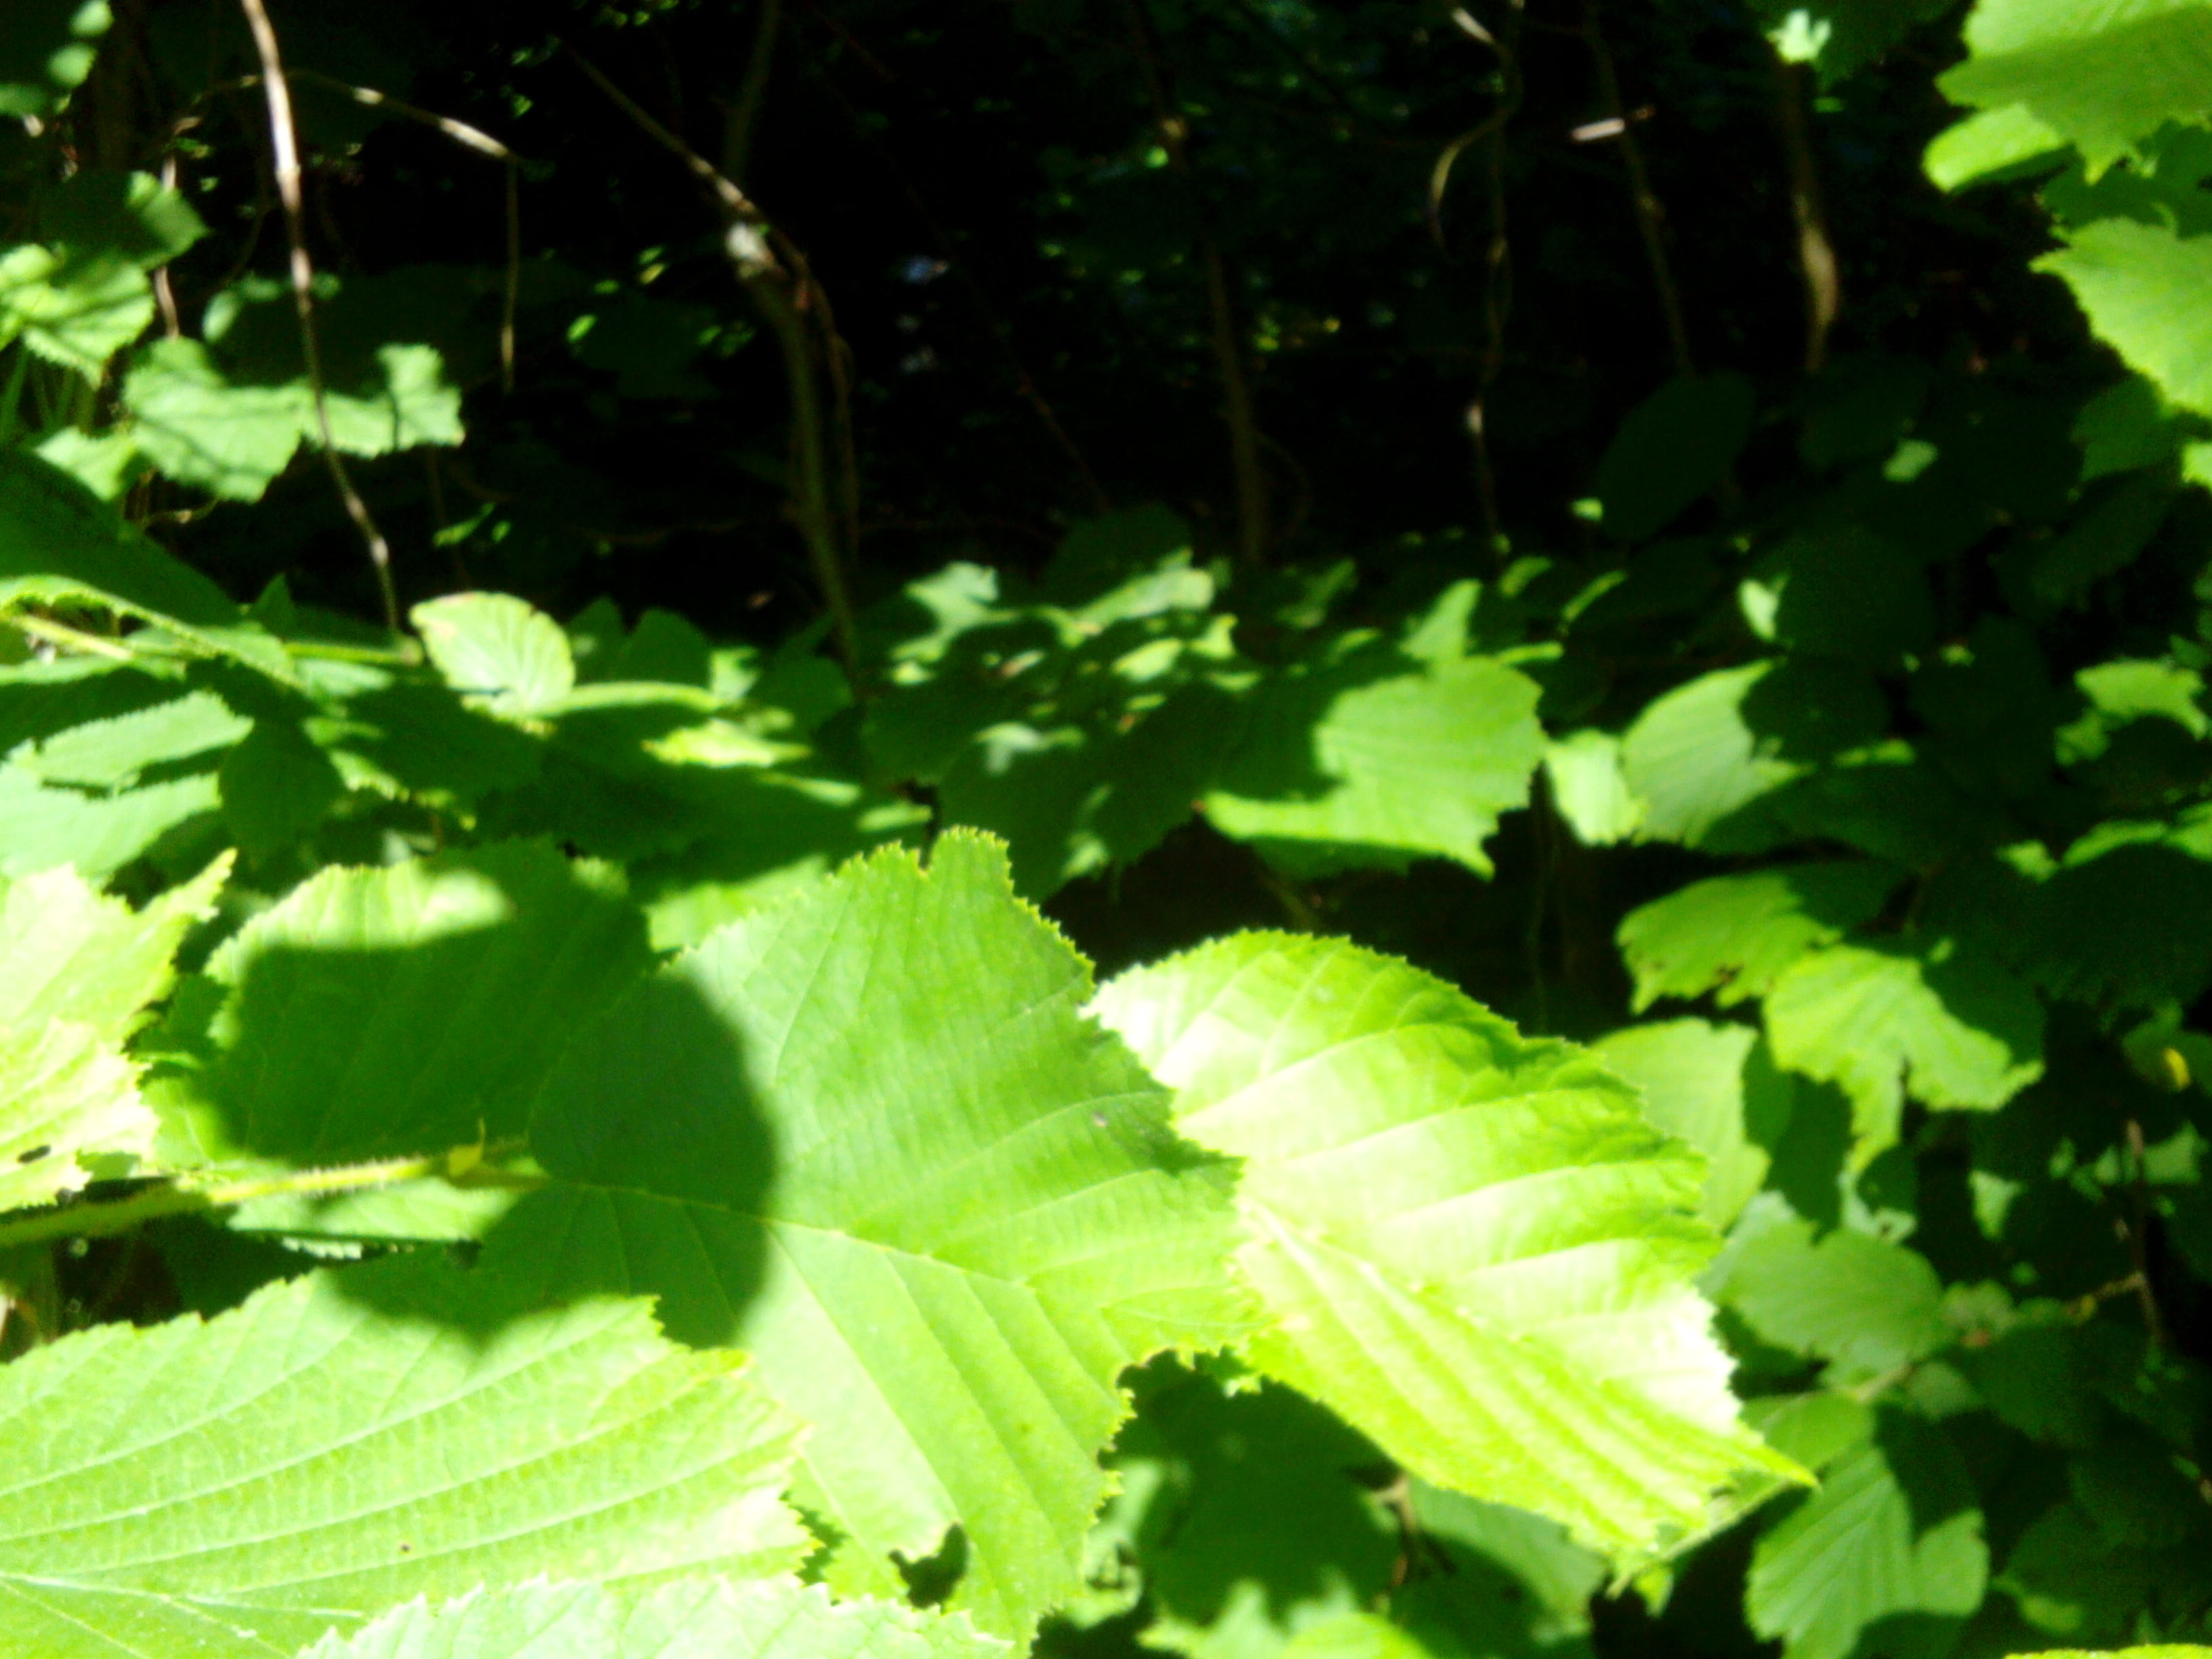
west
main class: Woodland
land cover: Broadleaved woodland
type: non-riverine alder, birch or aspen forest
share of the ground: 50 - 75 %
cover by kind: broadleaved forest trees 70 %, herbaceous plants 30 %
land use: Forestry
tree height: > 5 m
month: July
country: LV
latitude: 56.4349
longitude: 22.0679
